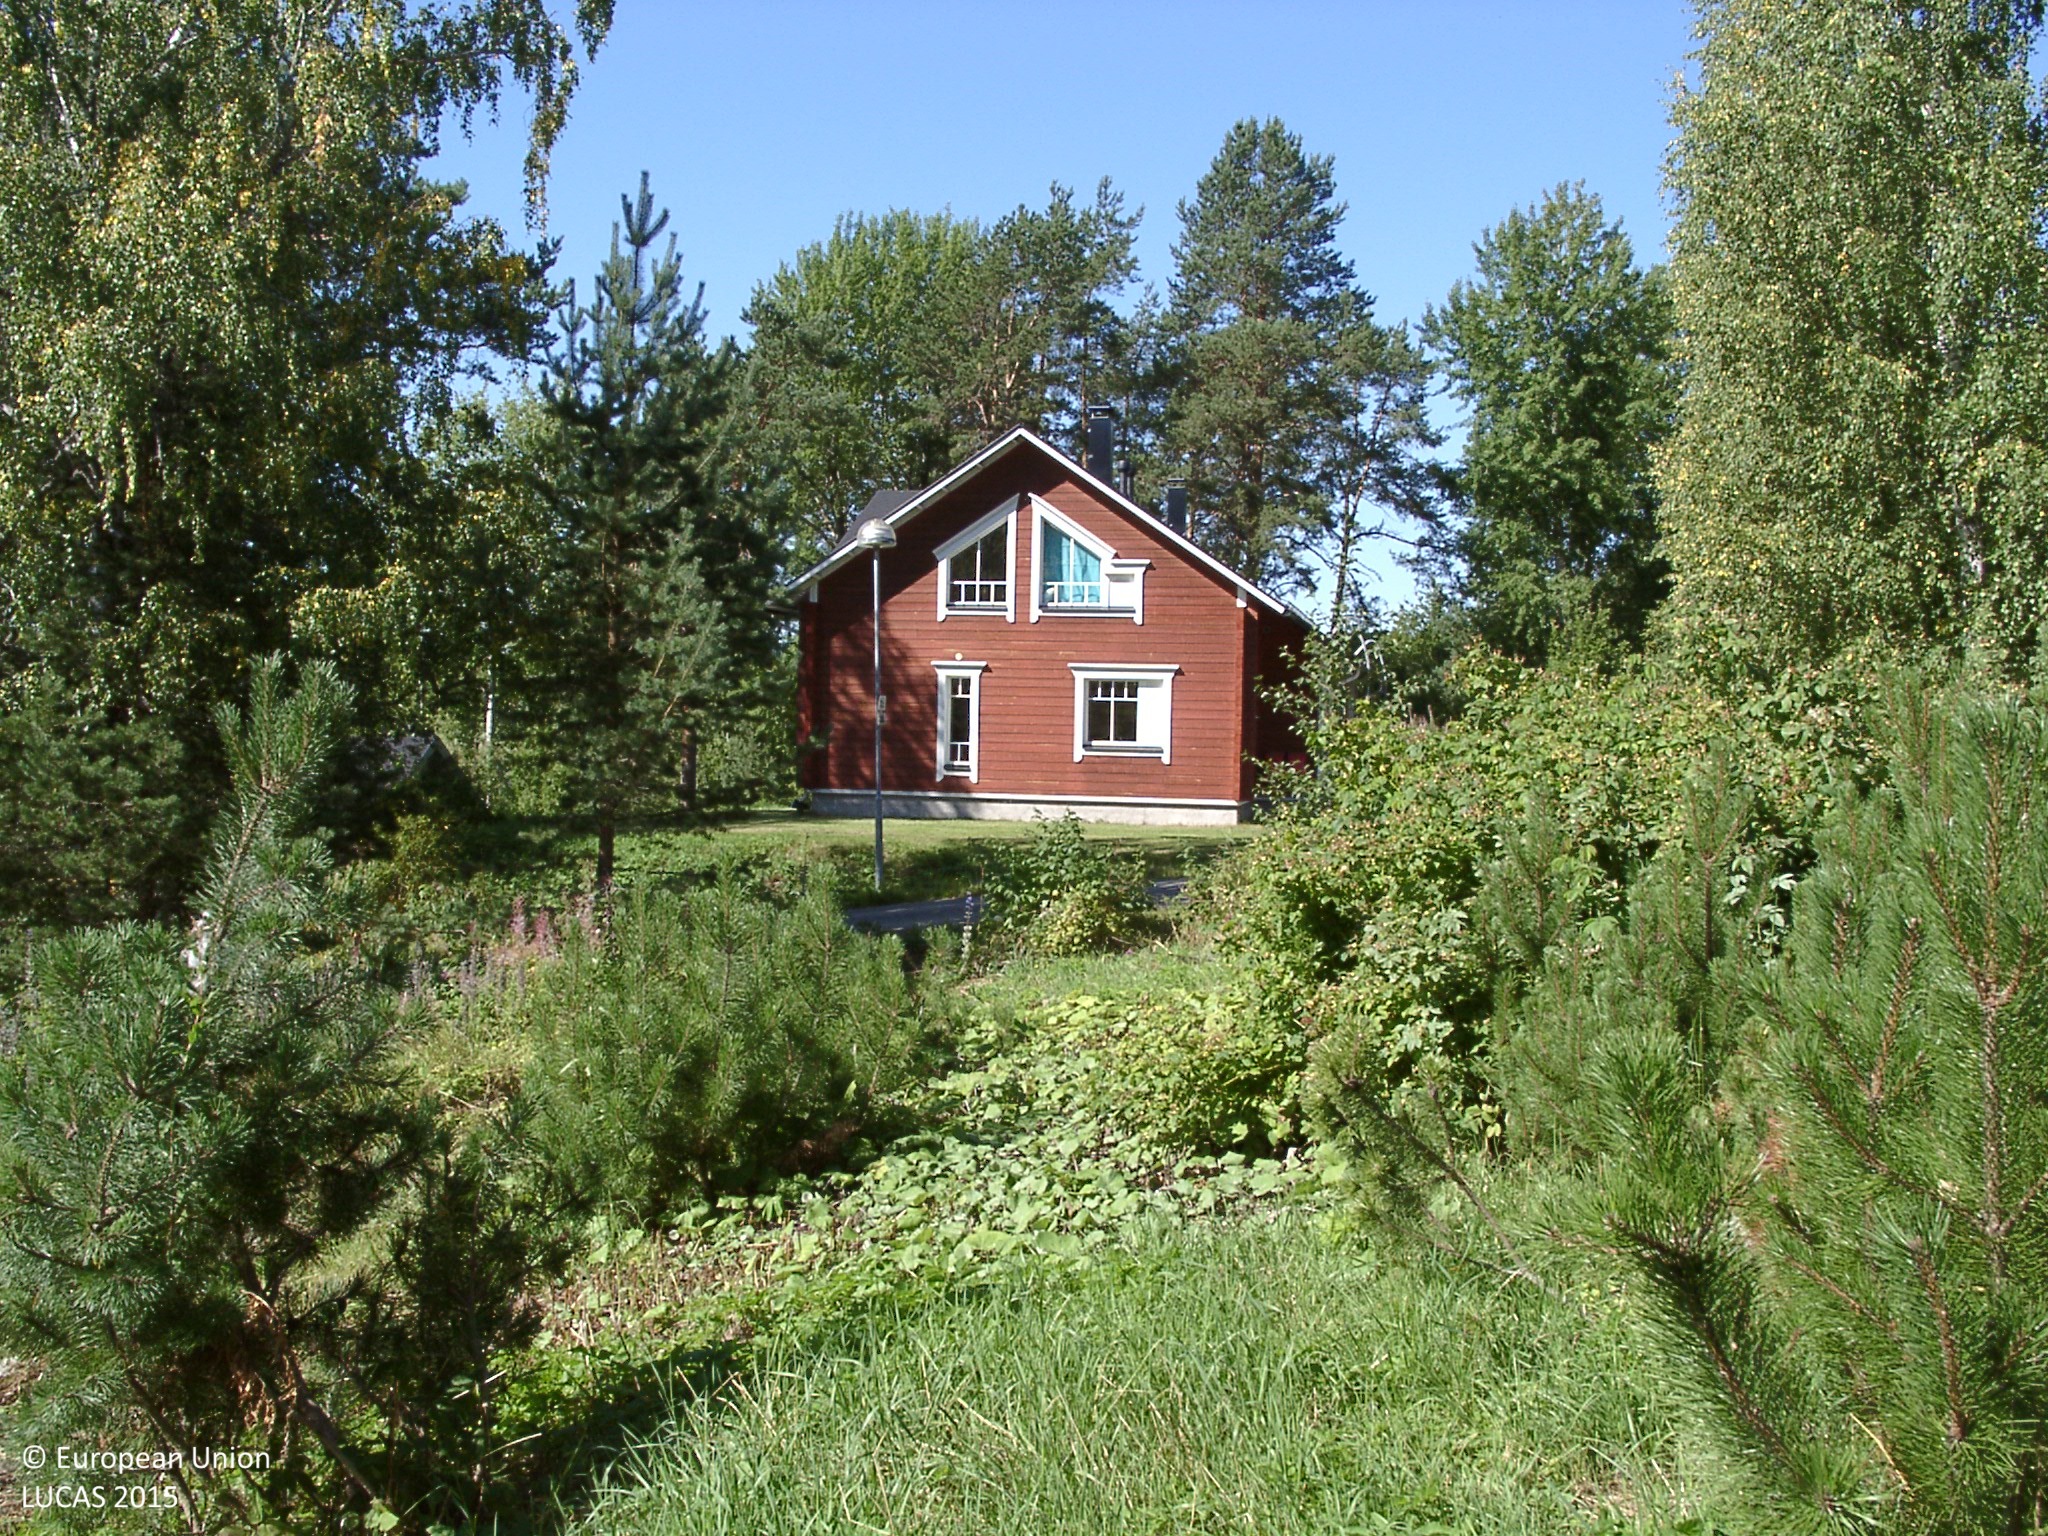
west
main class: Grassland
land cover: Spontaneously vegetated surfaces
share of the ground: > 75 %
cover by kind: herbaceous plants 100 %
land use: Residential
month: August
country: FI
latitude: 61.8954
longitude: 25.3170
